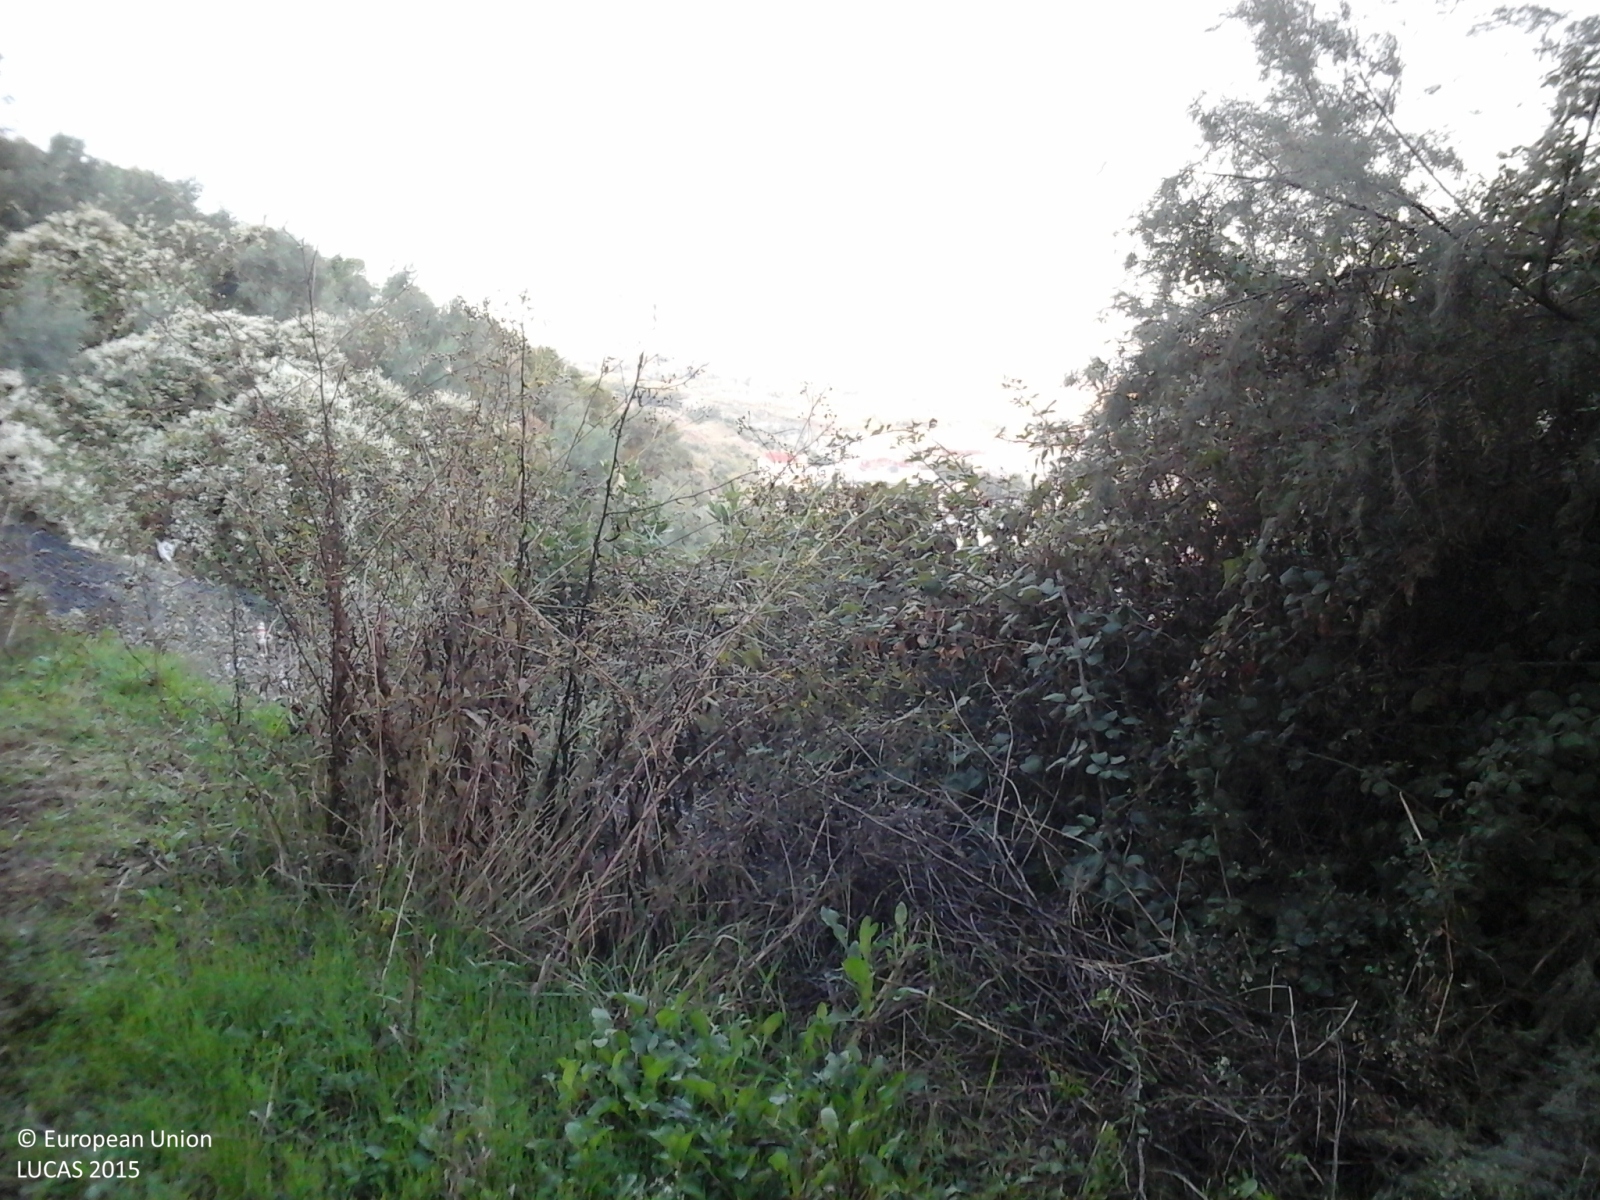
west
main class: Woodland
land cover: Broadleaved woodland
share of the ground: > 75 %
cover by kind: broadleaved forest trees 100 %
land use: Residential
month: October
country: IT
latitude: 43.6055
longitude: 13.4979
